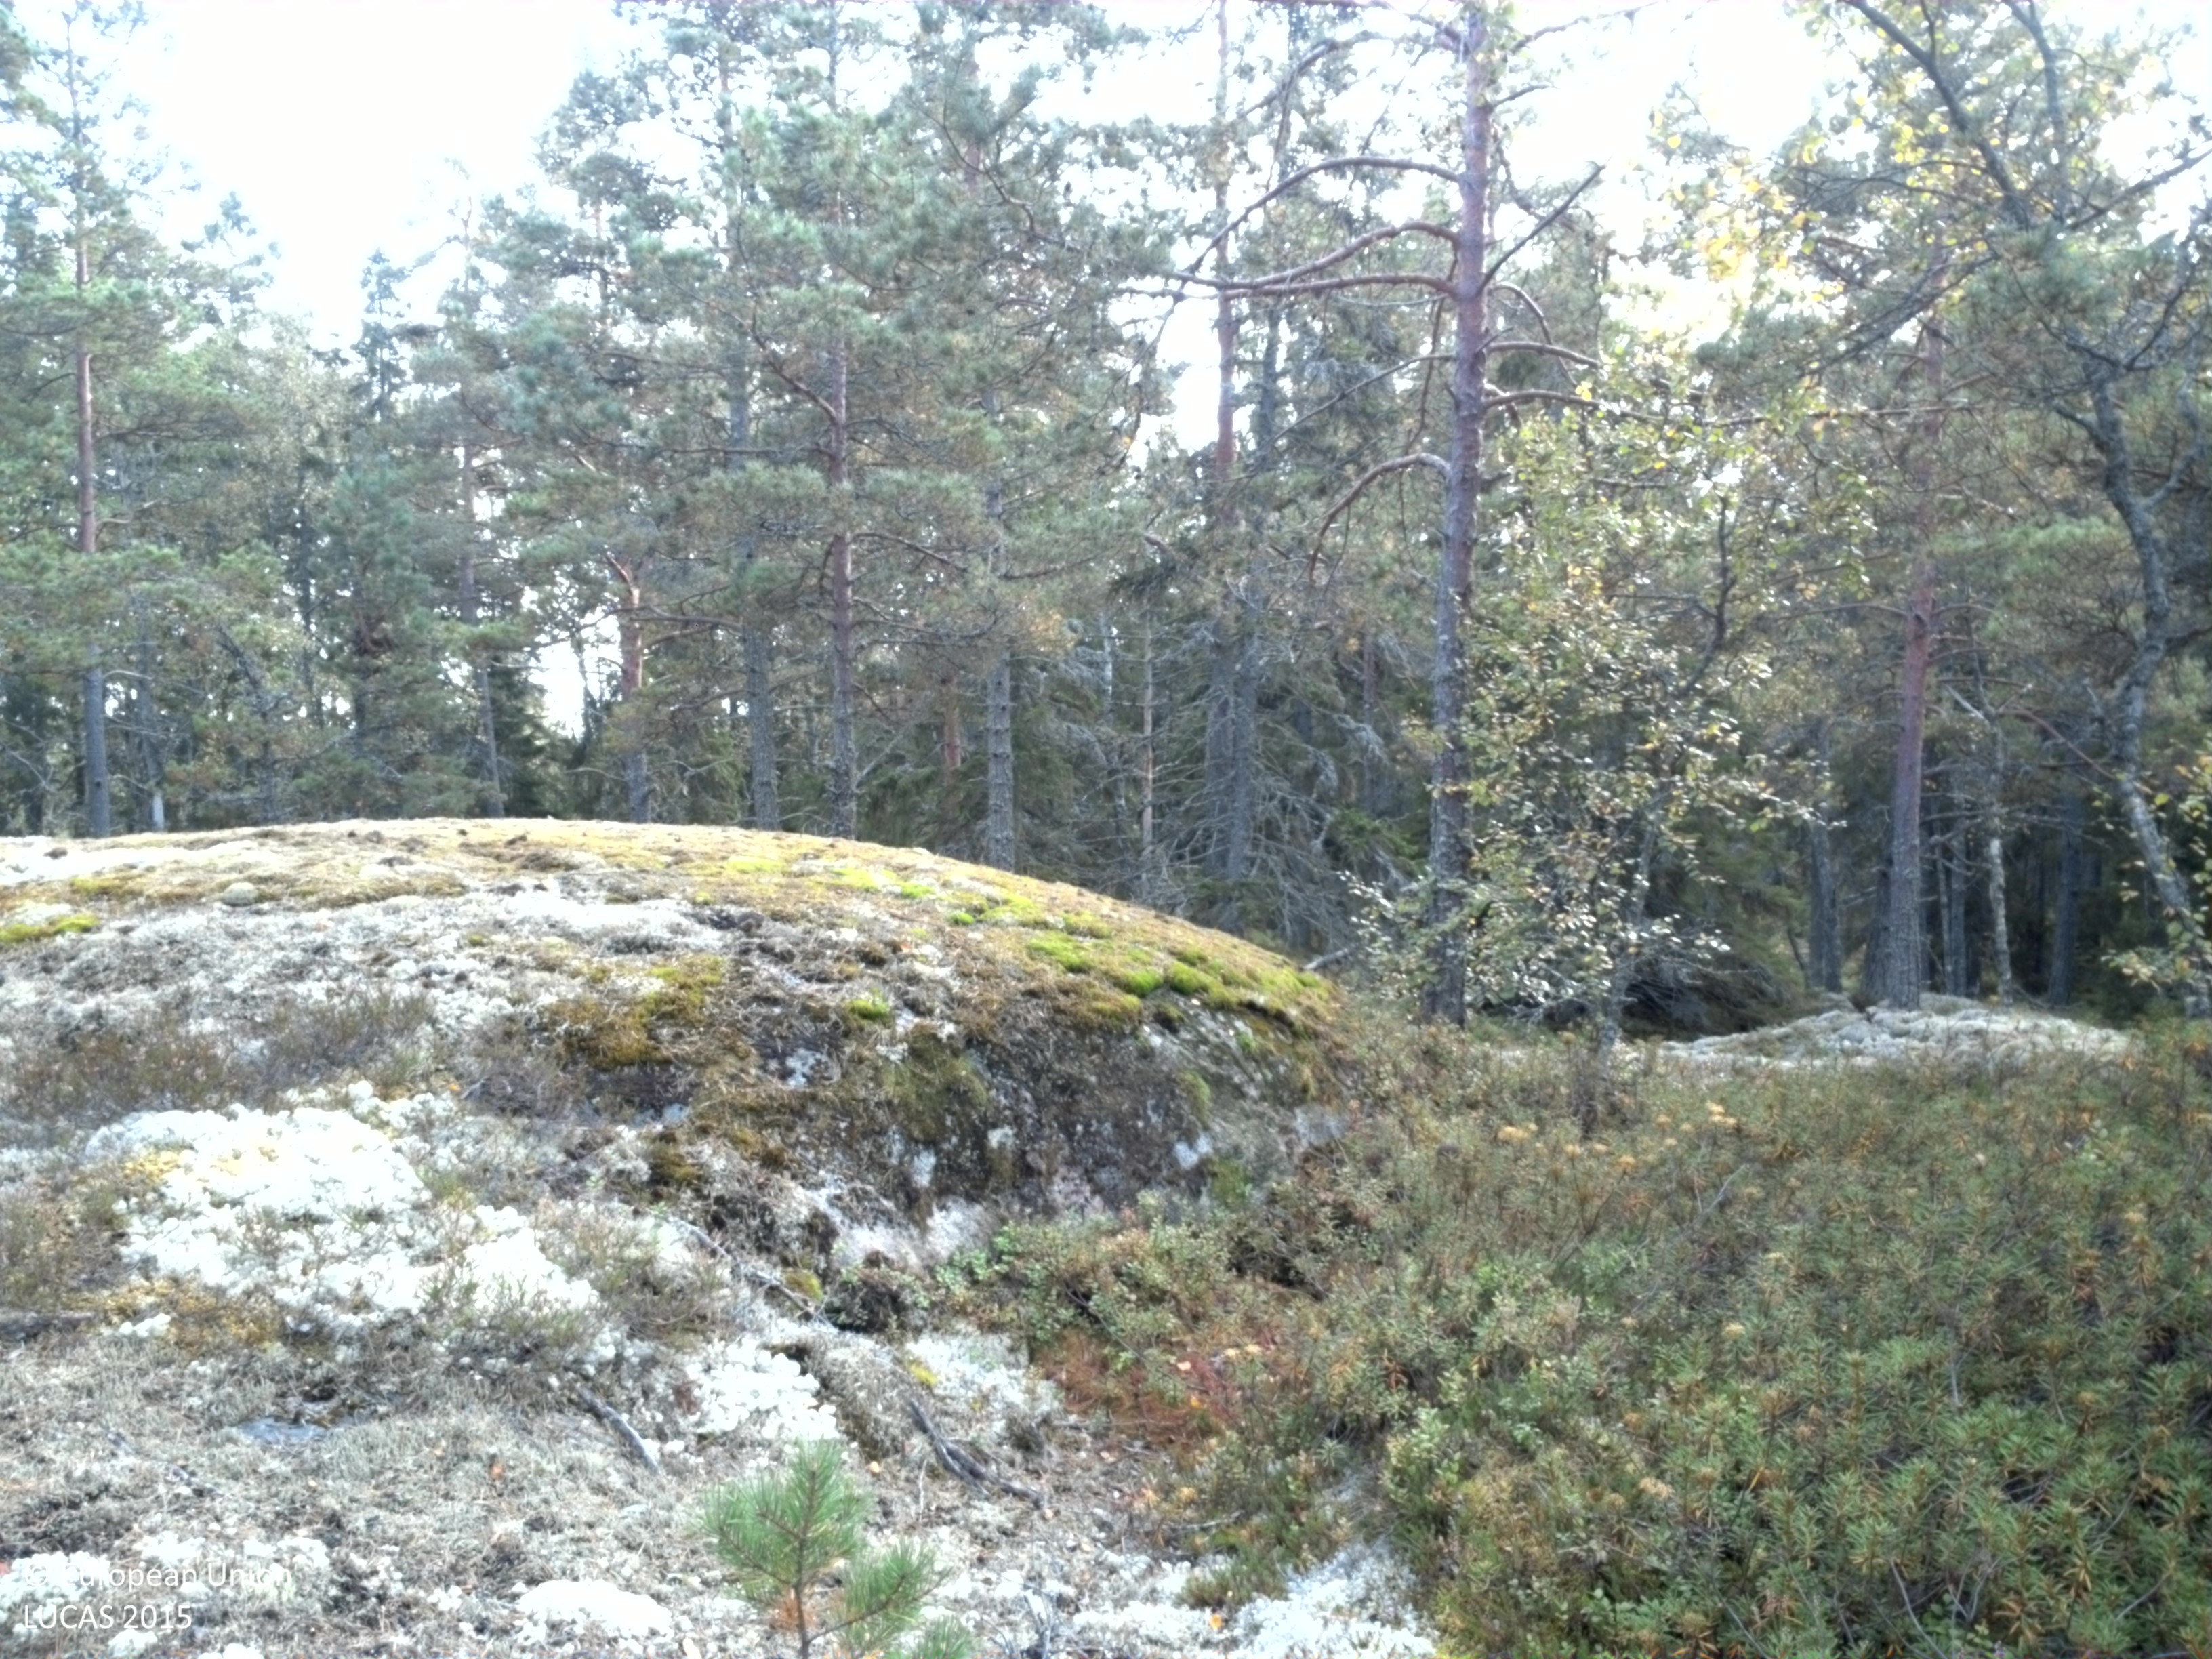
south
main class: Woodland
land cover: Pine dominated coniferous woodland
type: boreal forest
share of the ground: 50 - 75 %
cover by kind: coniferous forest trees 60 %, shrubs 20 %, consolidated bare surface 15 %, lichens and mosses 5 %
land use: Forestry
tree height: > 5 m
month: September
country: SE
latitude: 59.8131
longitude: 18.8262
